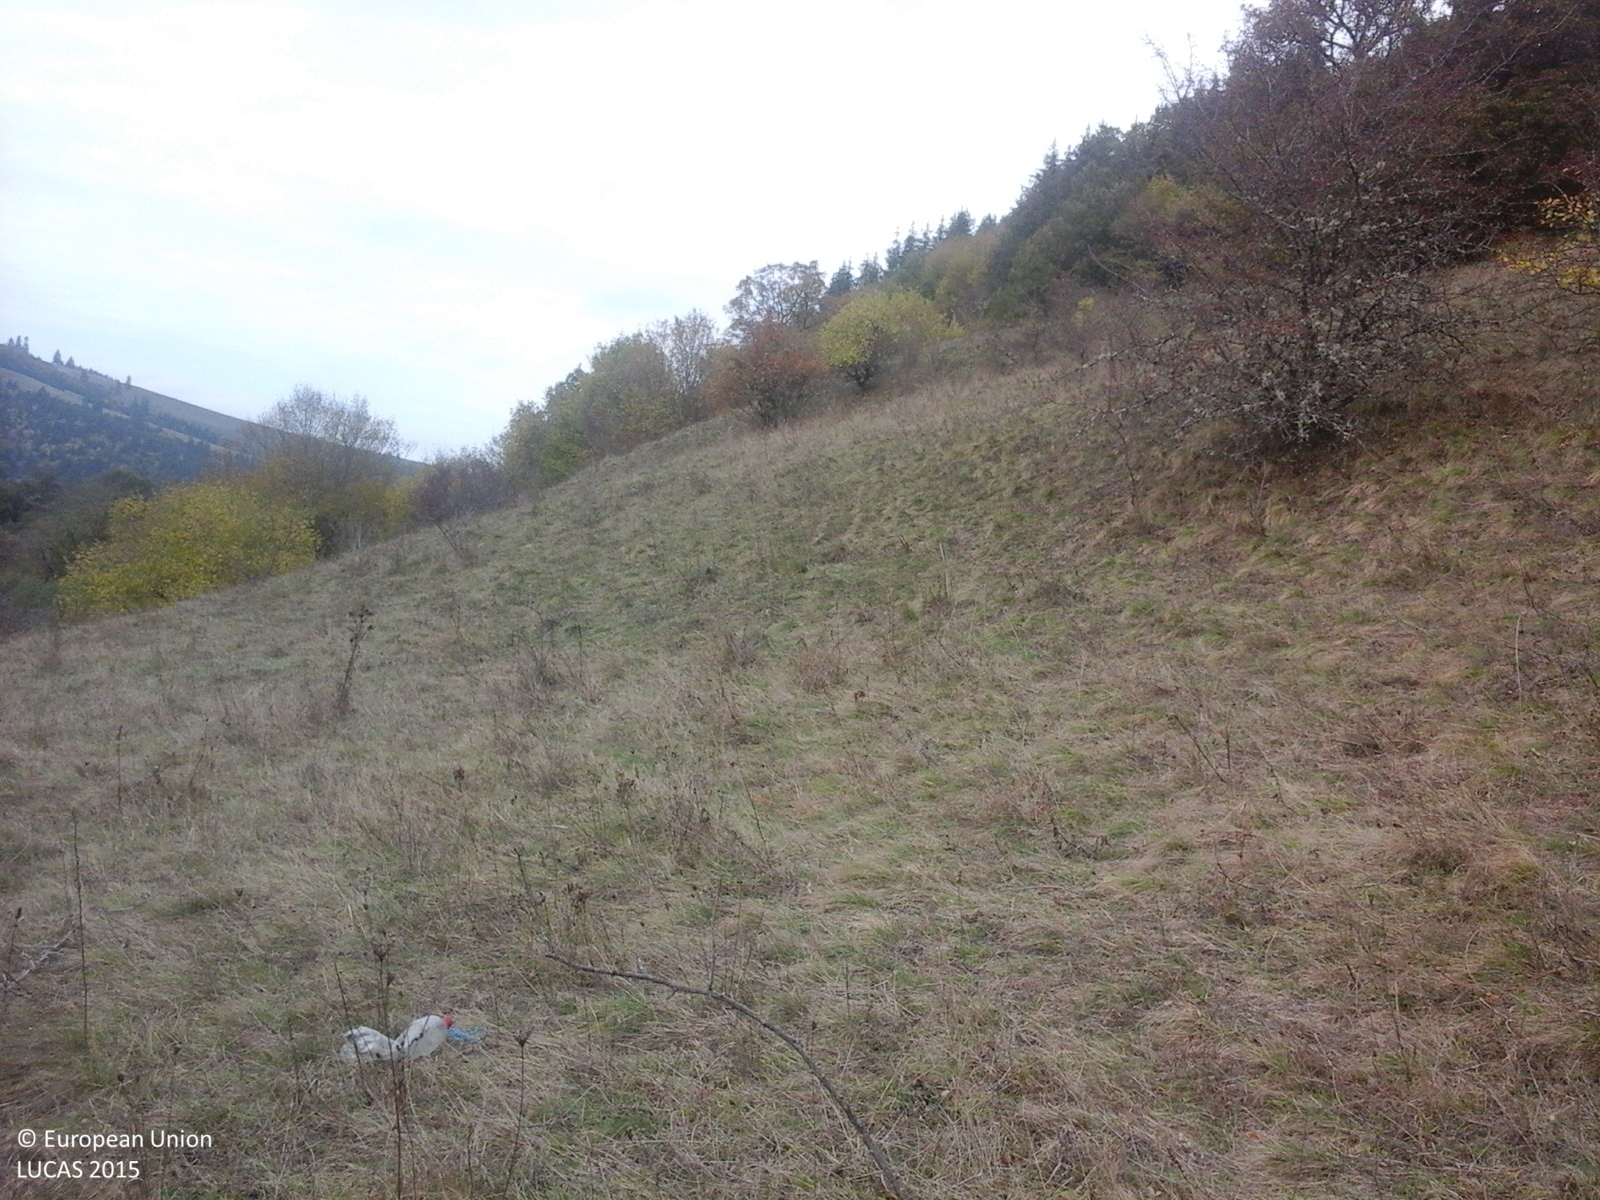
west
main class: Grassland
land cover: Grassland without tree/shrub cover
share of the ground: > 75 %
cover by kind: herbaceous plants 100 %
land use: Agriculture (excluding fallow land and kitchen gardens)
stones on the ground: < 10 %
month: October
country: RO
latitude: 46.1475
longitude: 26.1104
